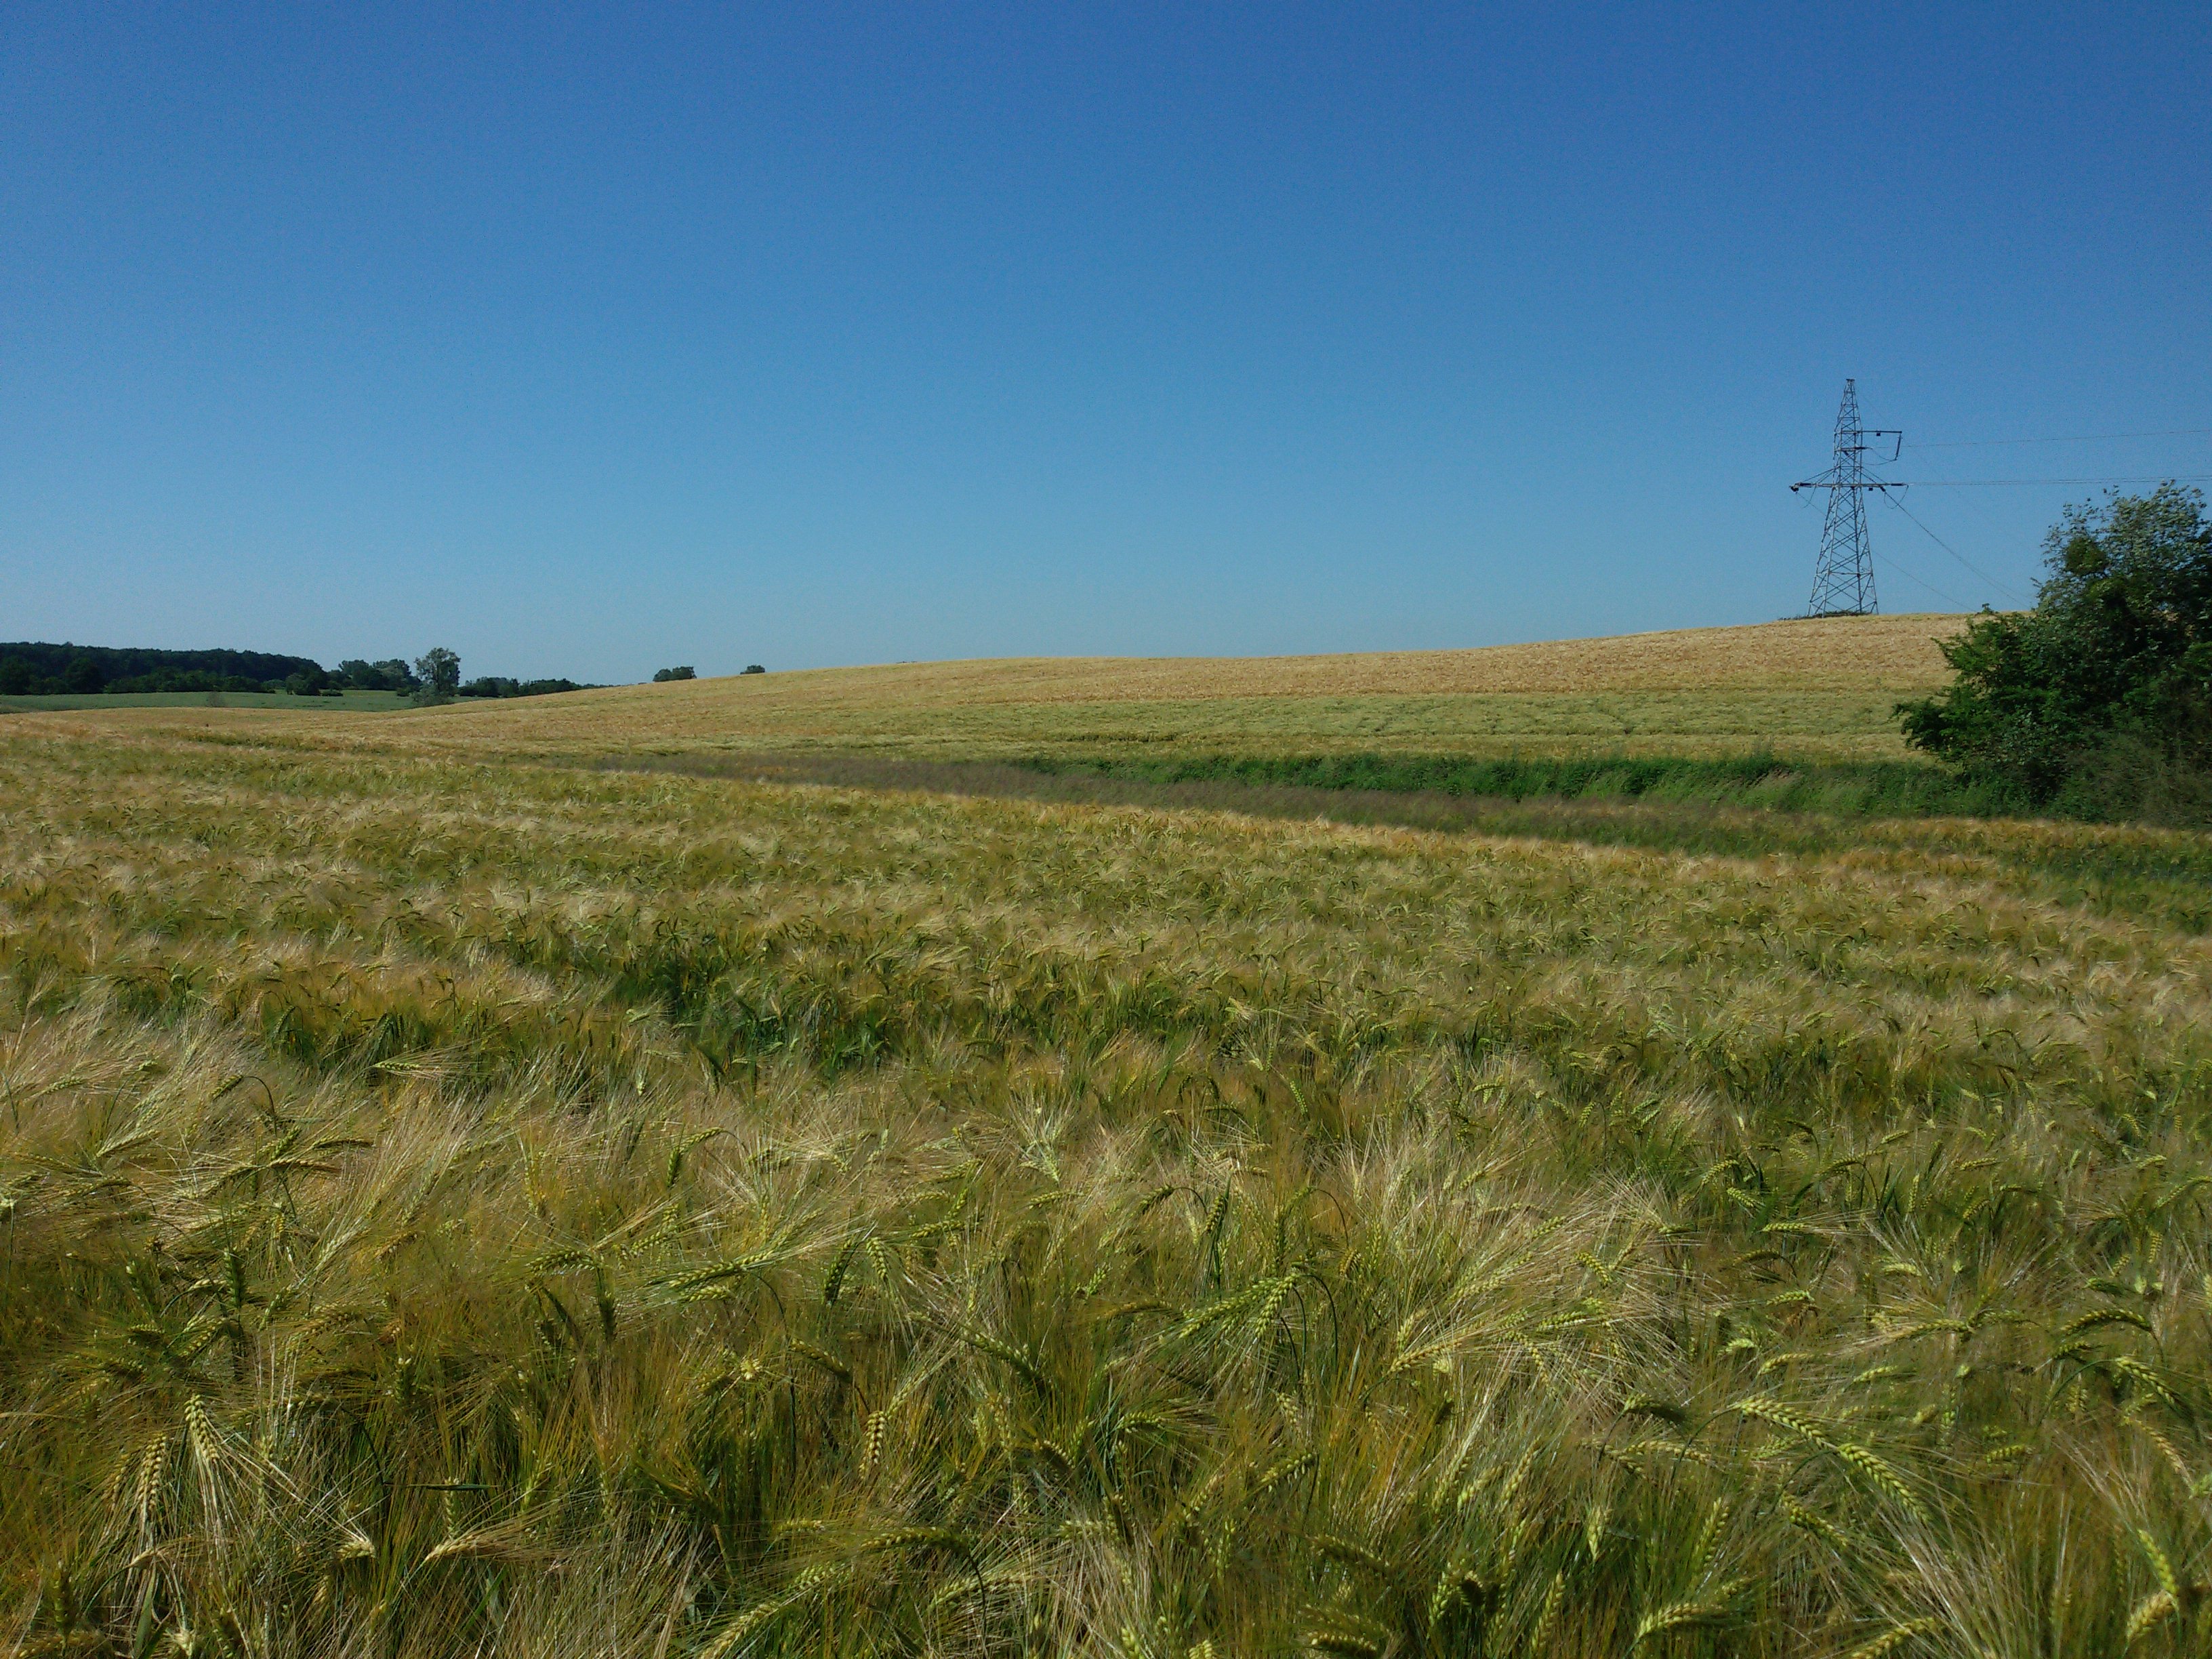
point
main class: Cropland
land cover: Barley
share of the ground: > 75 %
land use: Agriculture (excluding fallow land and kitchen gardens)
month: July
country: PL
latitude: 53.3143
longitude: 14.6094
